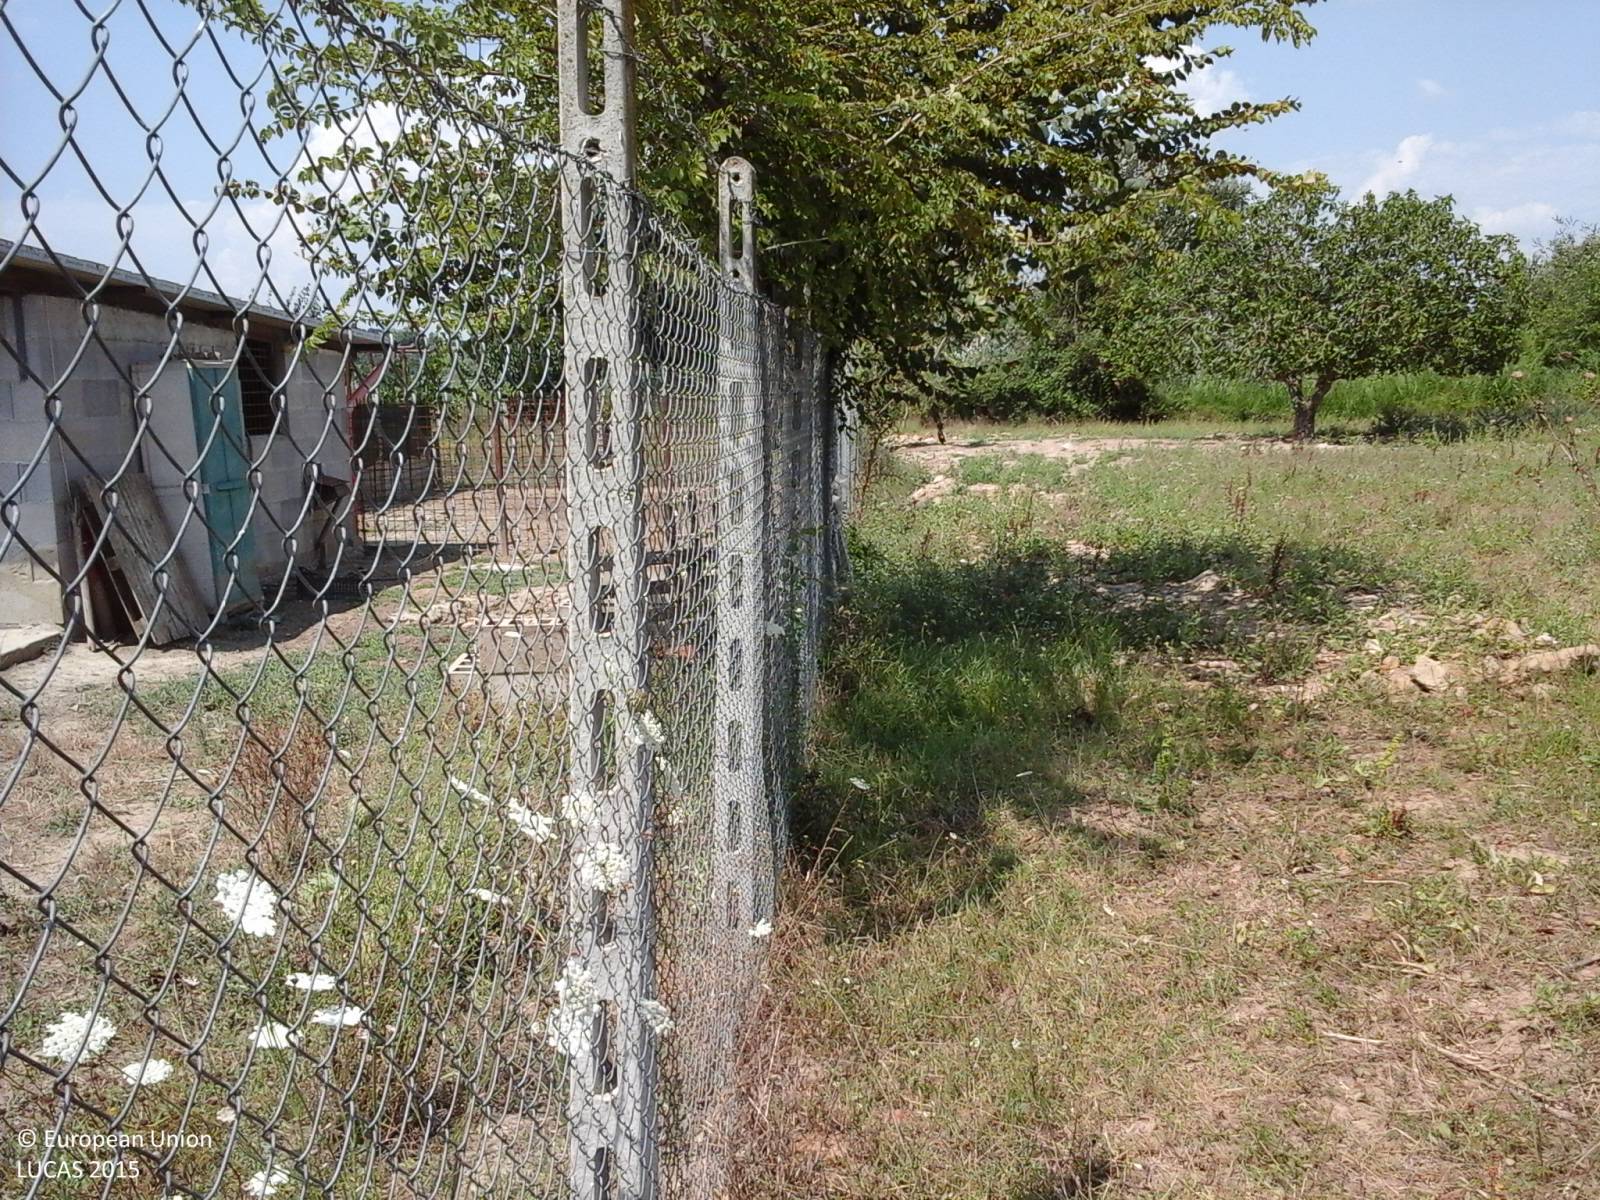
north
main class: Grassland
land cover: Spontaneously vegetated surfaces
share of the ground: 25 - 50 %
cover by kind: herbaceous plants 90 %, unconsolidated bare surface 10 %
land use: Fallow land
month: July
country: IT
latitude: 42.0264
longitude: 12.5151
